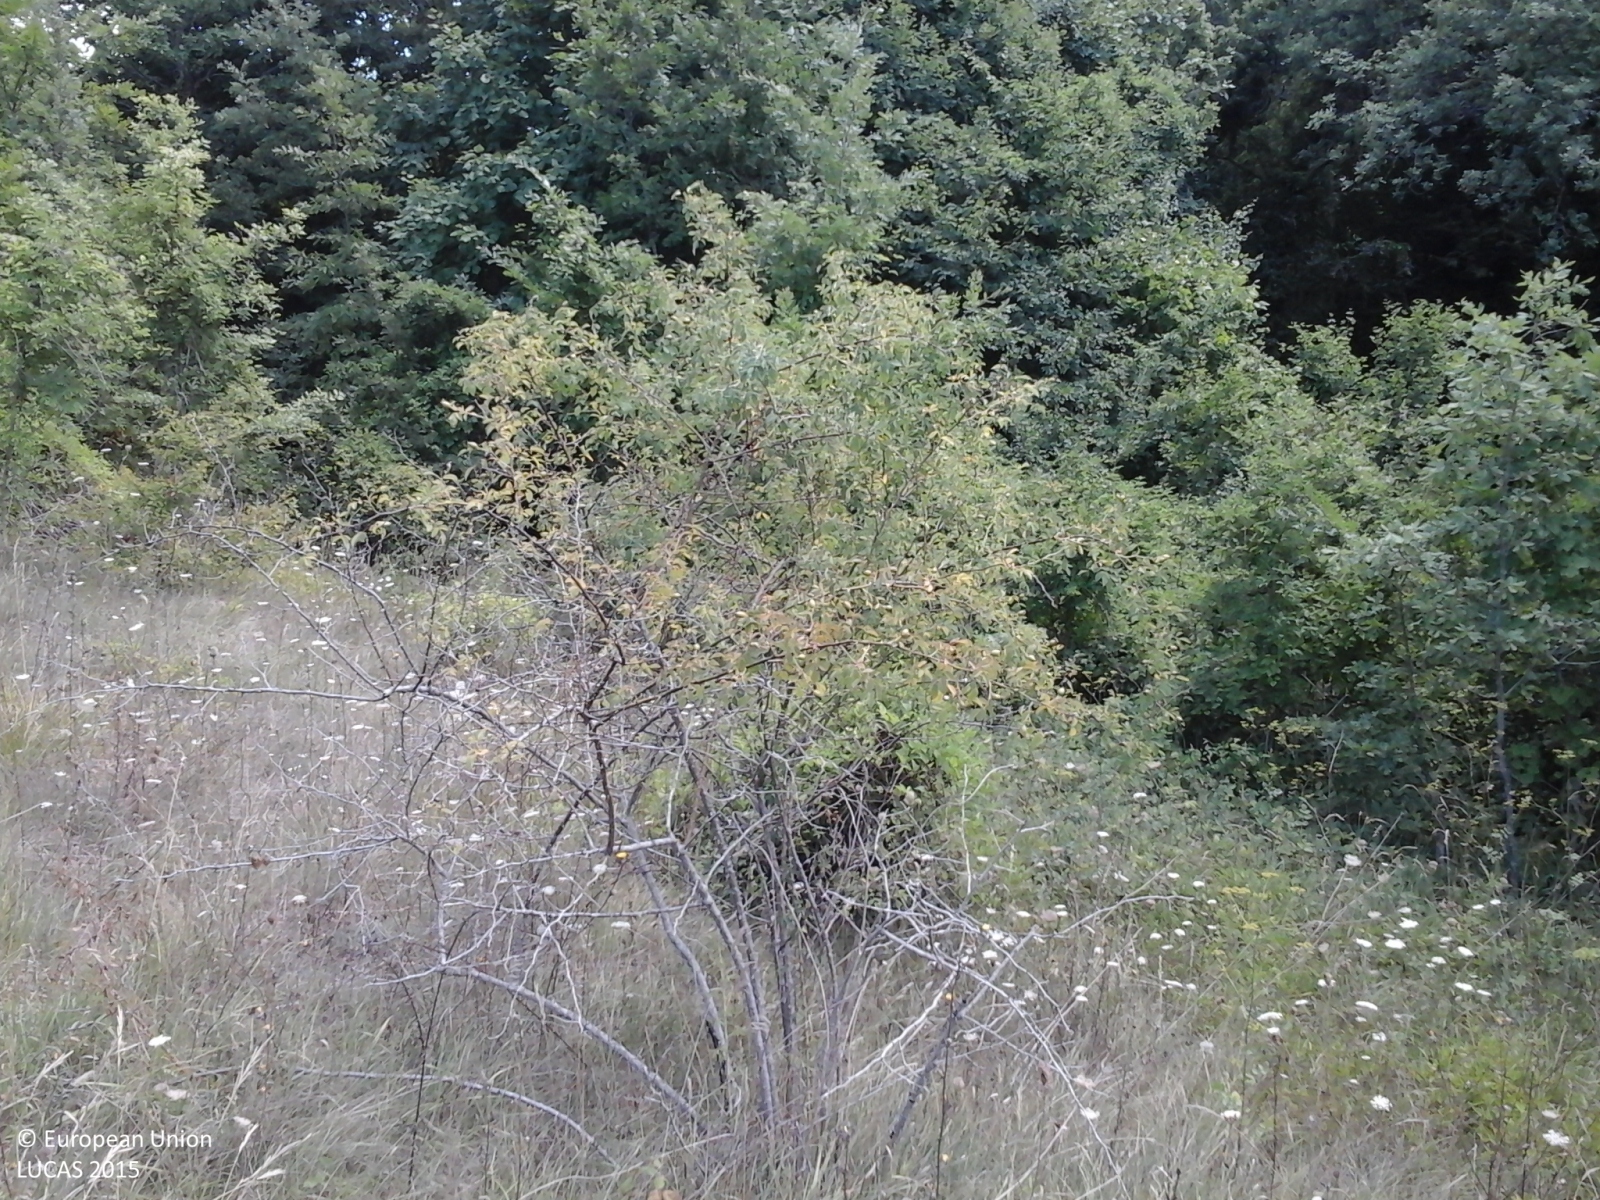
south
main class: Woodland
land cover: Broadleaved woodland
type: thermophilous deciduous forest
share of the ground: > 75 %
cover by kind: broadleaved forest trees 75 %, shrubs 20 %, herbaceous plants 5 %
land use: Semi-natural and natural areas not in use
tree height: > 5 m
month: August
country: IT
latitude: 41.5831
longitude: 14.3626
